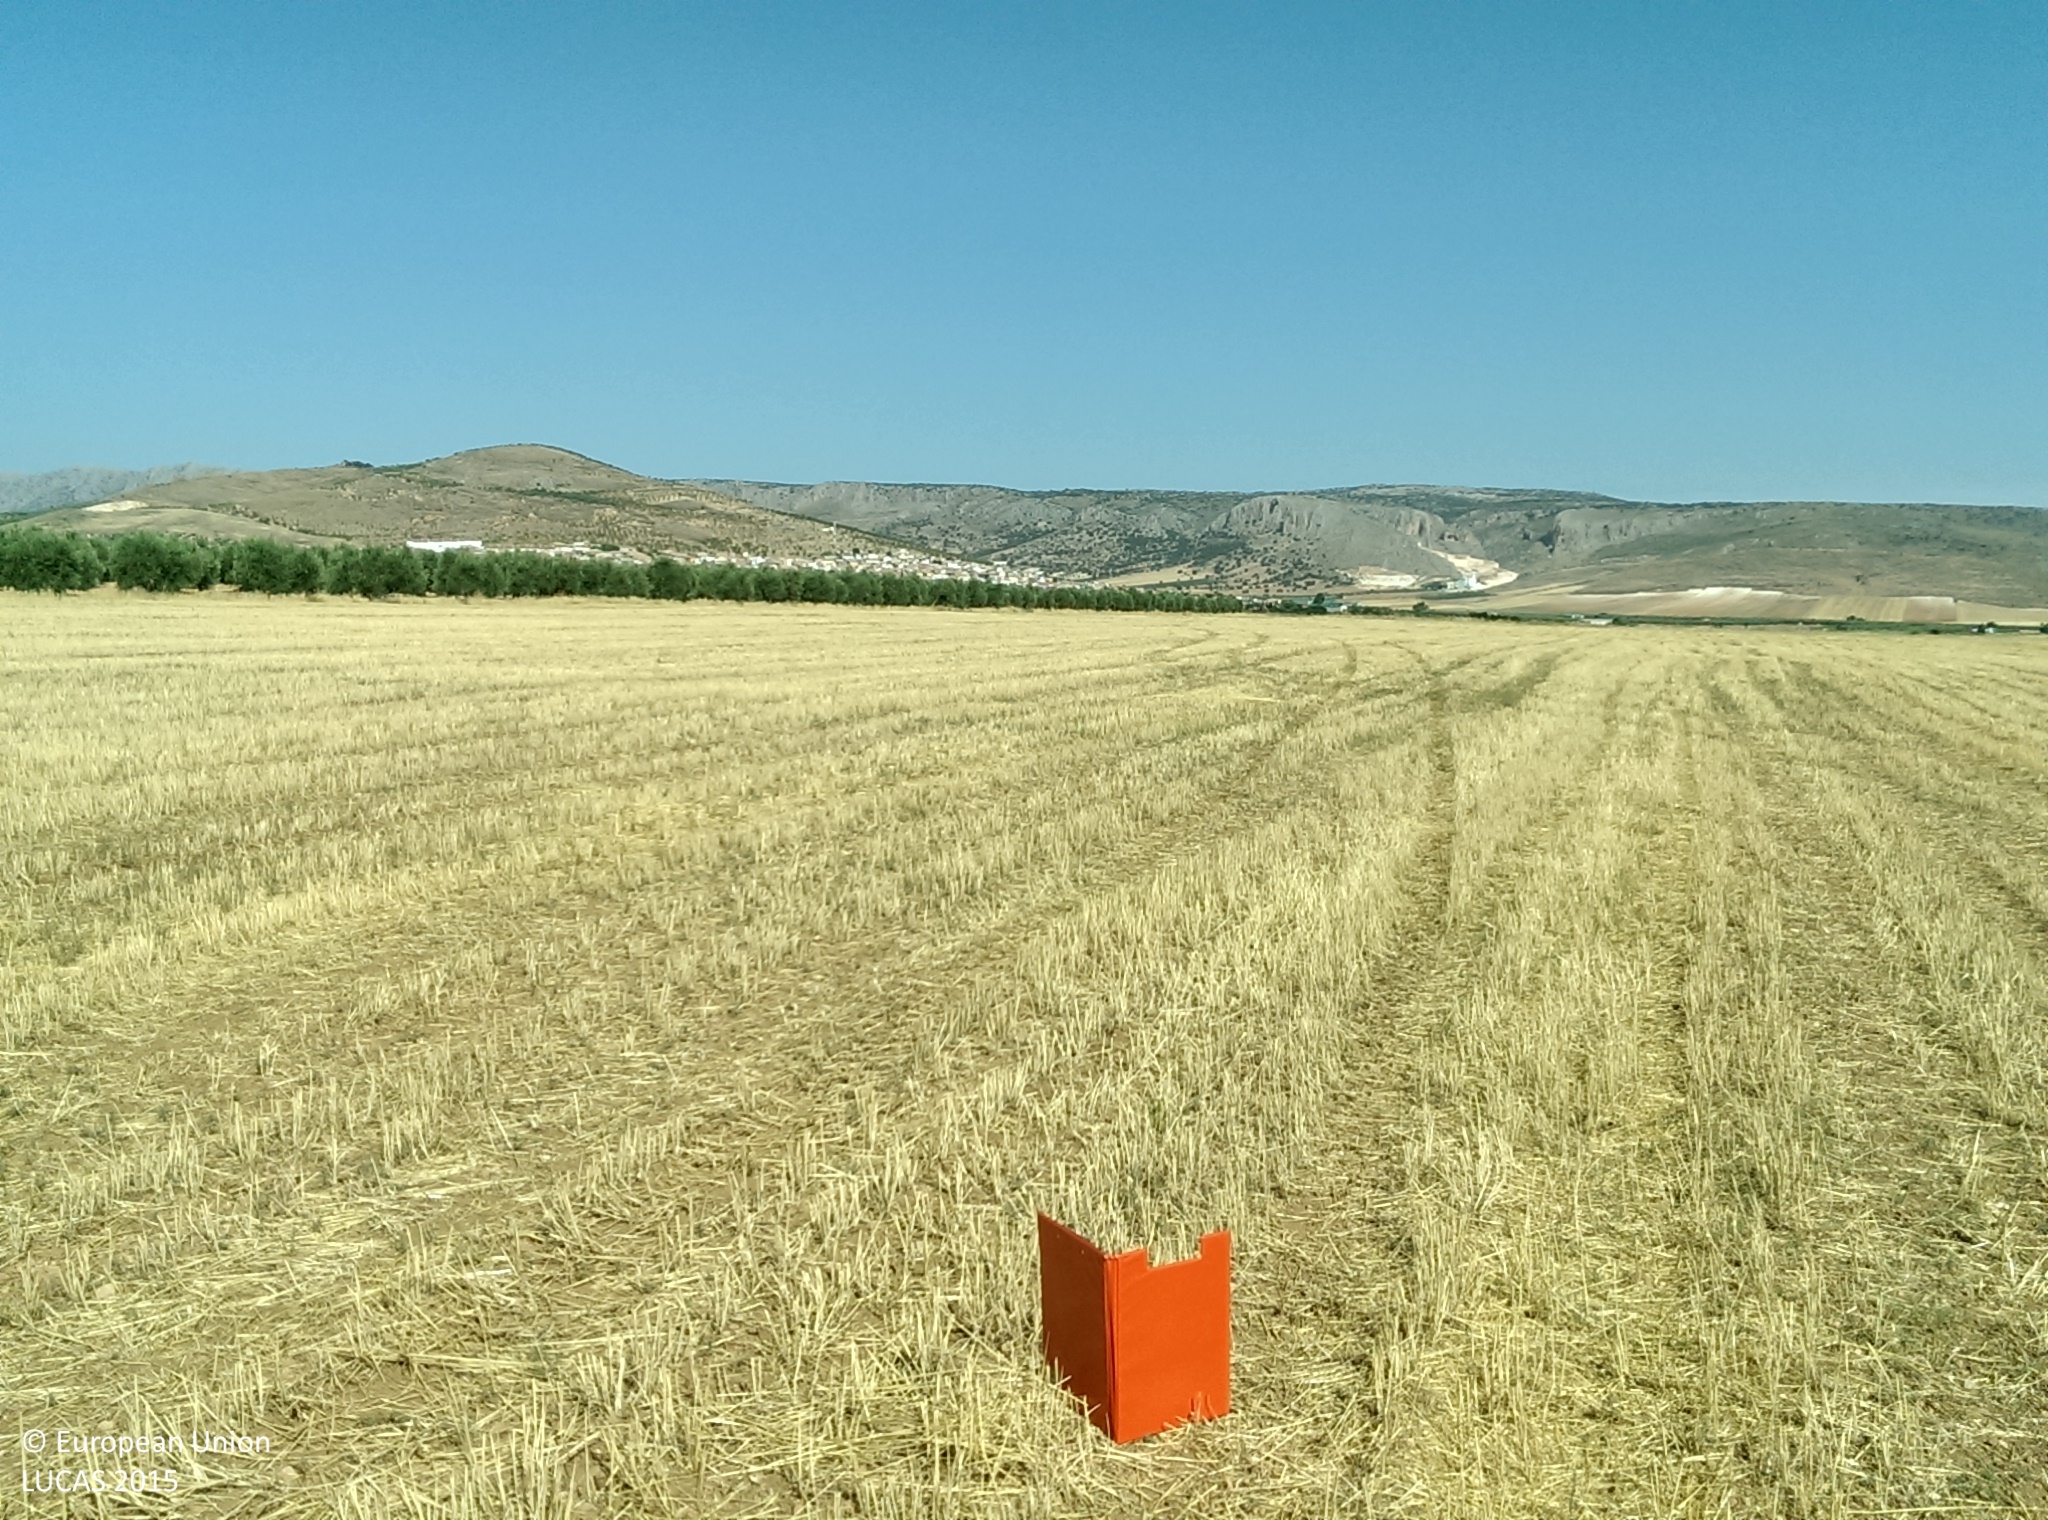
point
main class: Cropland
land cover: Barley
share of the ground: < 10 %
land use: Agriculture (excluding fallow land and kitchen gardens)
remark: Harvested field
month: July
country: ES
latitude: 37.3446
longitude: -3.2751
